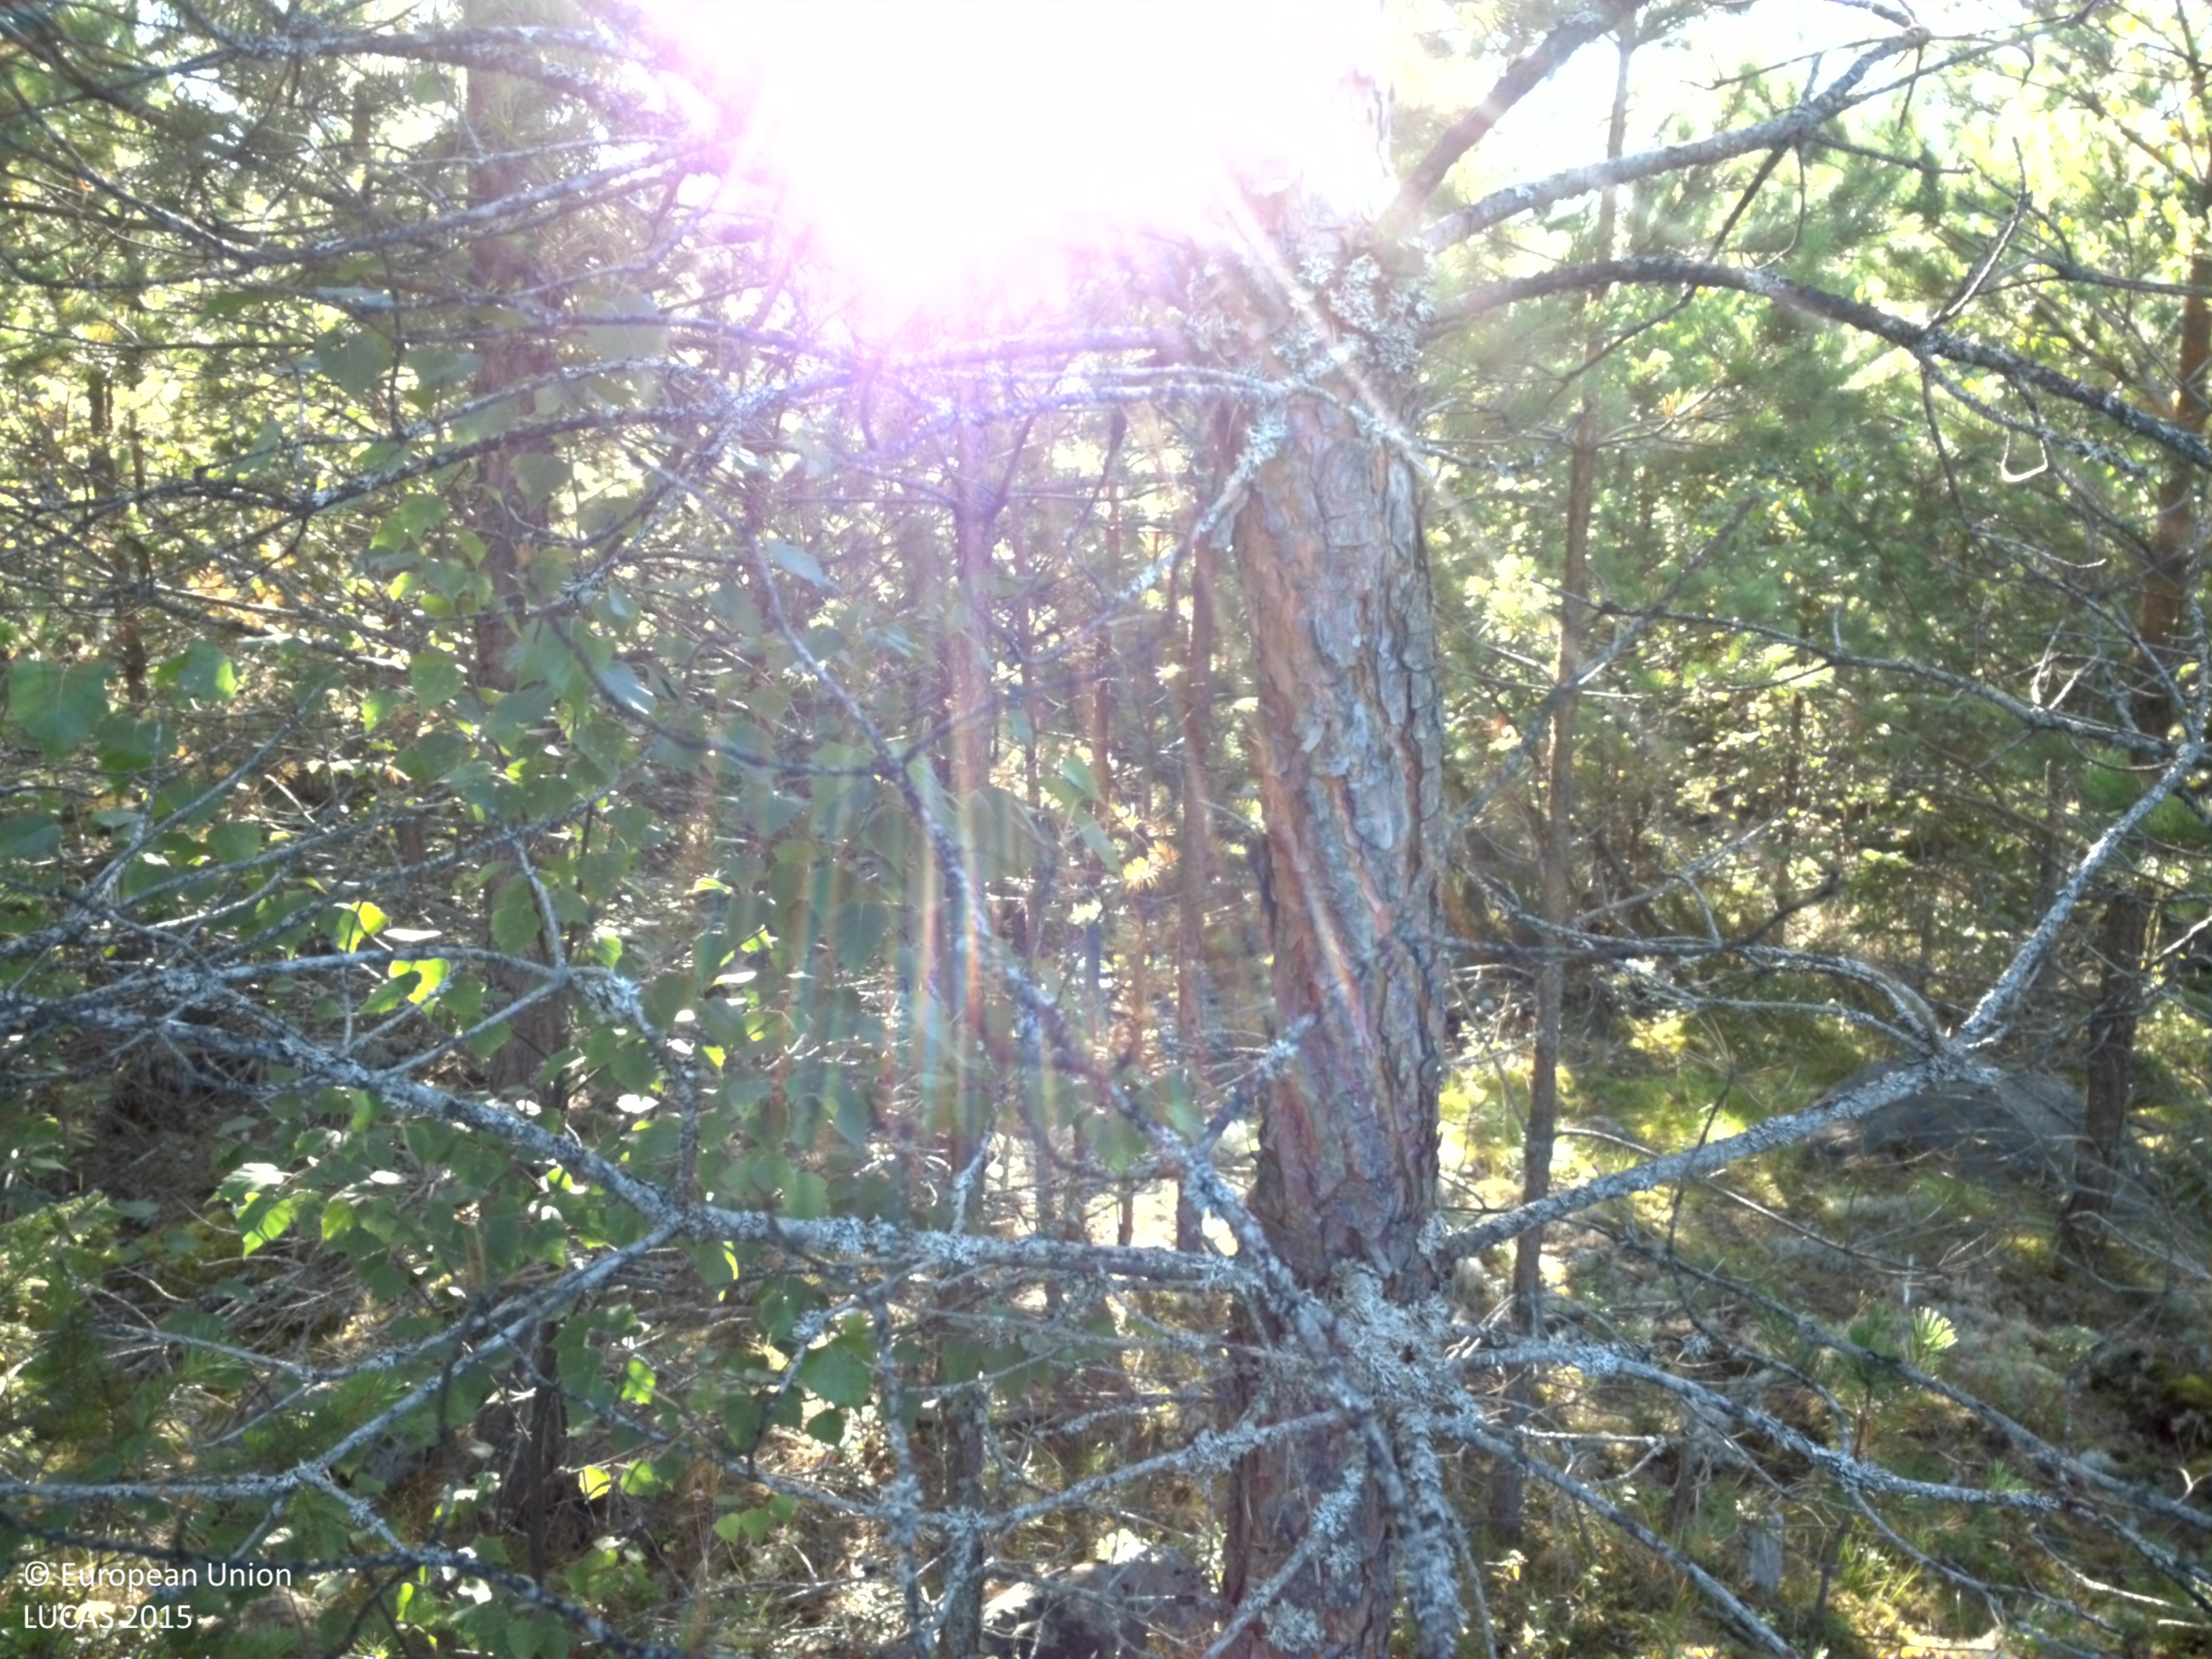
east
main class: Woodland
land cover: Pine dominated coniferous woodland
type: boreal forest
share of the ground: > 75 %
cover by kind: coniferous forest trees 65 %, shrubs 20 %, broadleaved forest trees 10 %, lichens and mosses 5 %
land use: Forestry
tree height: > 5 m
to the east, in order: Pine dominated coniferous woodland; Pine dominated mixed woodland; Other coniferous woodland; Spruce dominated mixed woodland
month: August
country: SE
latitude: 60.0907
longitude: 17.1295
